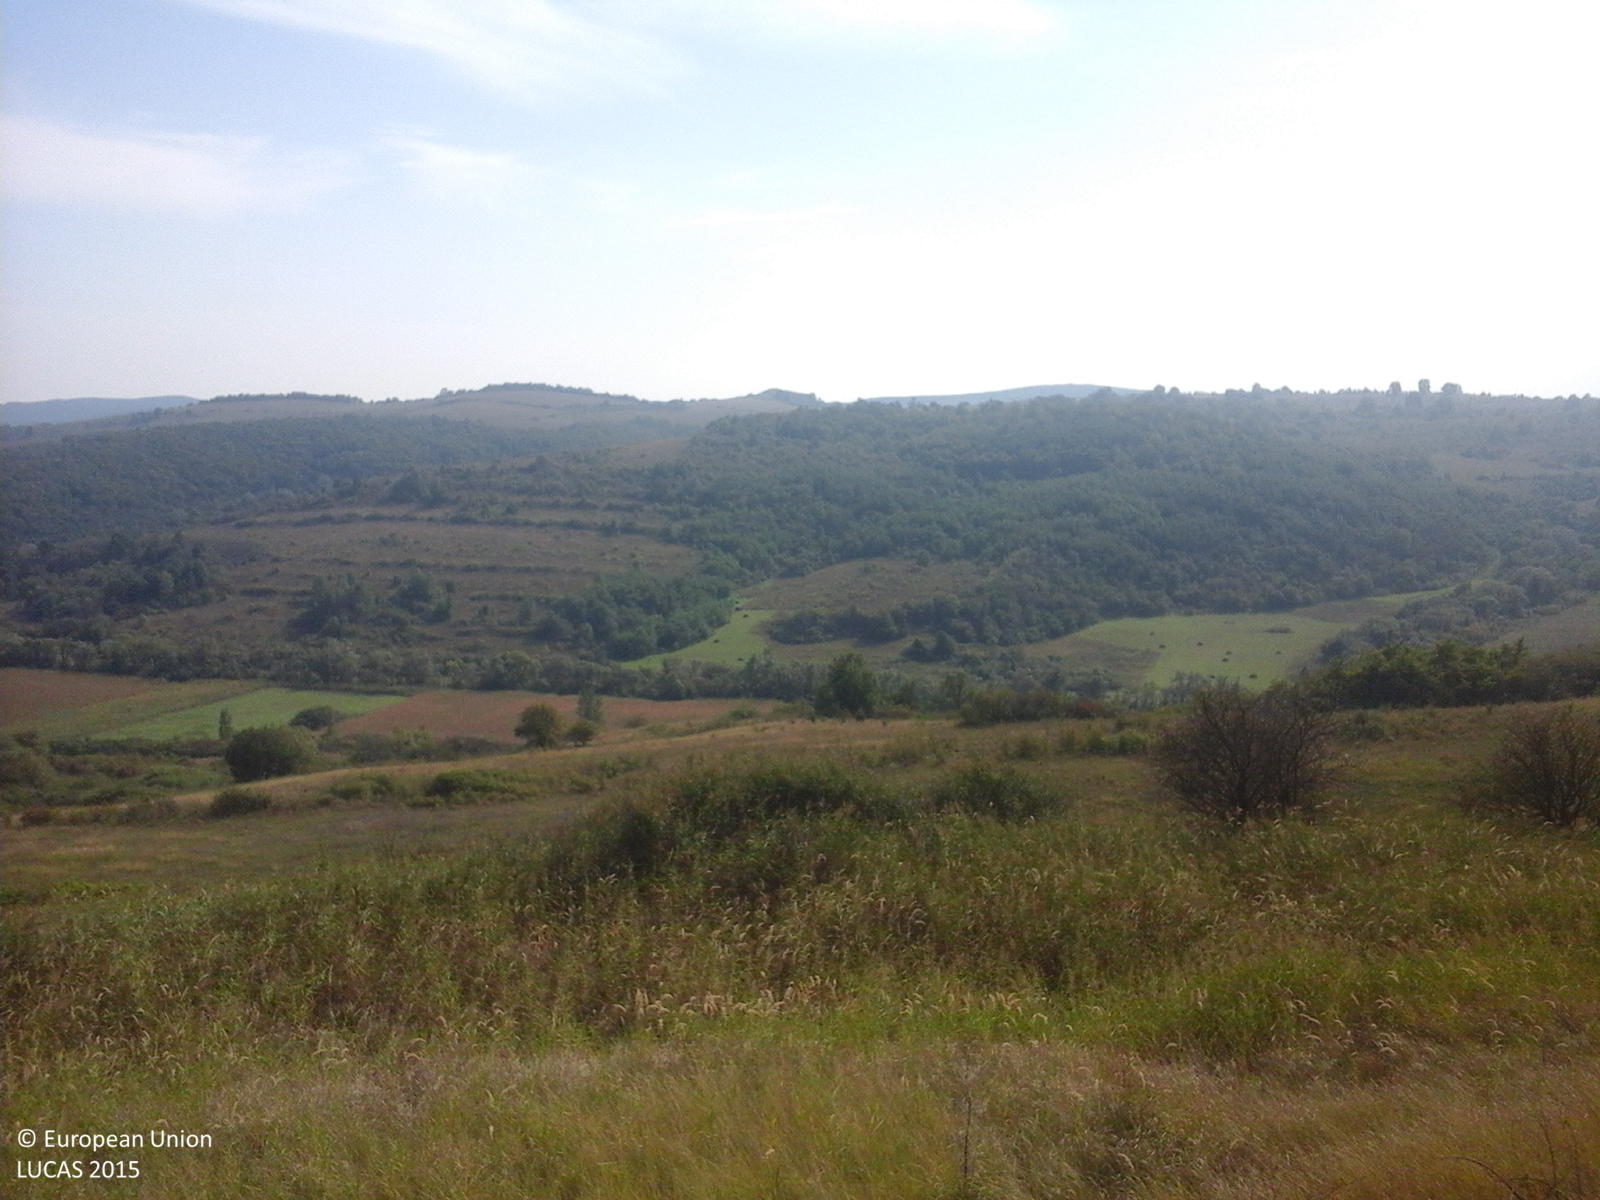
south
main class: Grassland
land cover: Grassland with sparse tree/shrub cover
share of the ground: > 75 %
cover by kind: herbaceous plants 90 %, broadleaved forest trees 5 %, shrubs 5 %
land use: Fallow land
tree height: < 5 m
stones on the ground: < 10 %
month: September
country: RO
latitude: 47.0457
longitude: 23.3225
